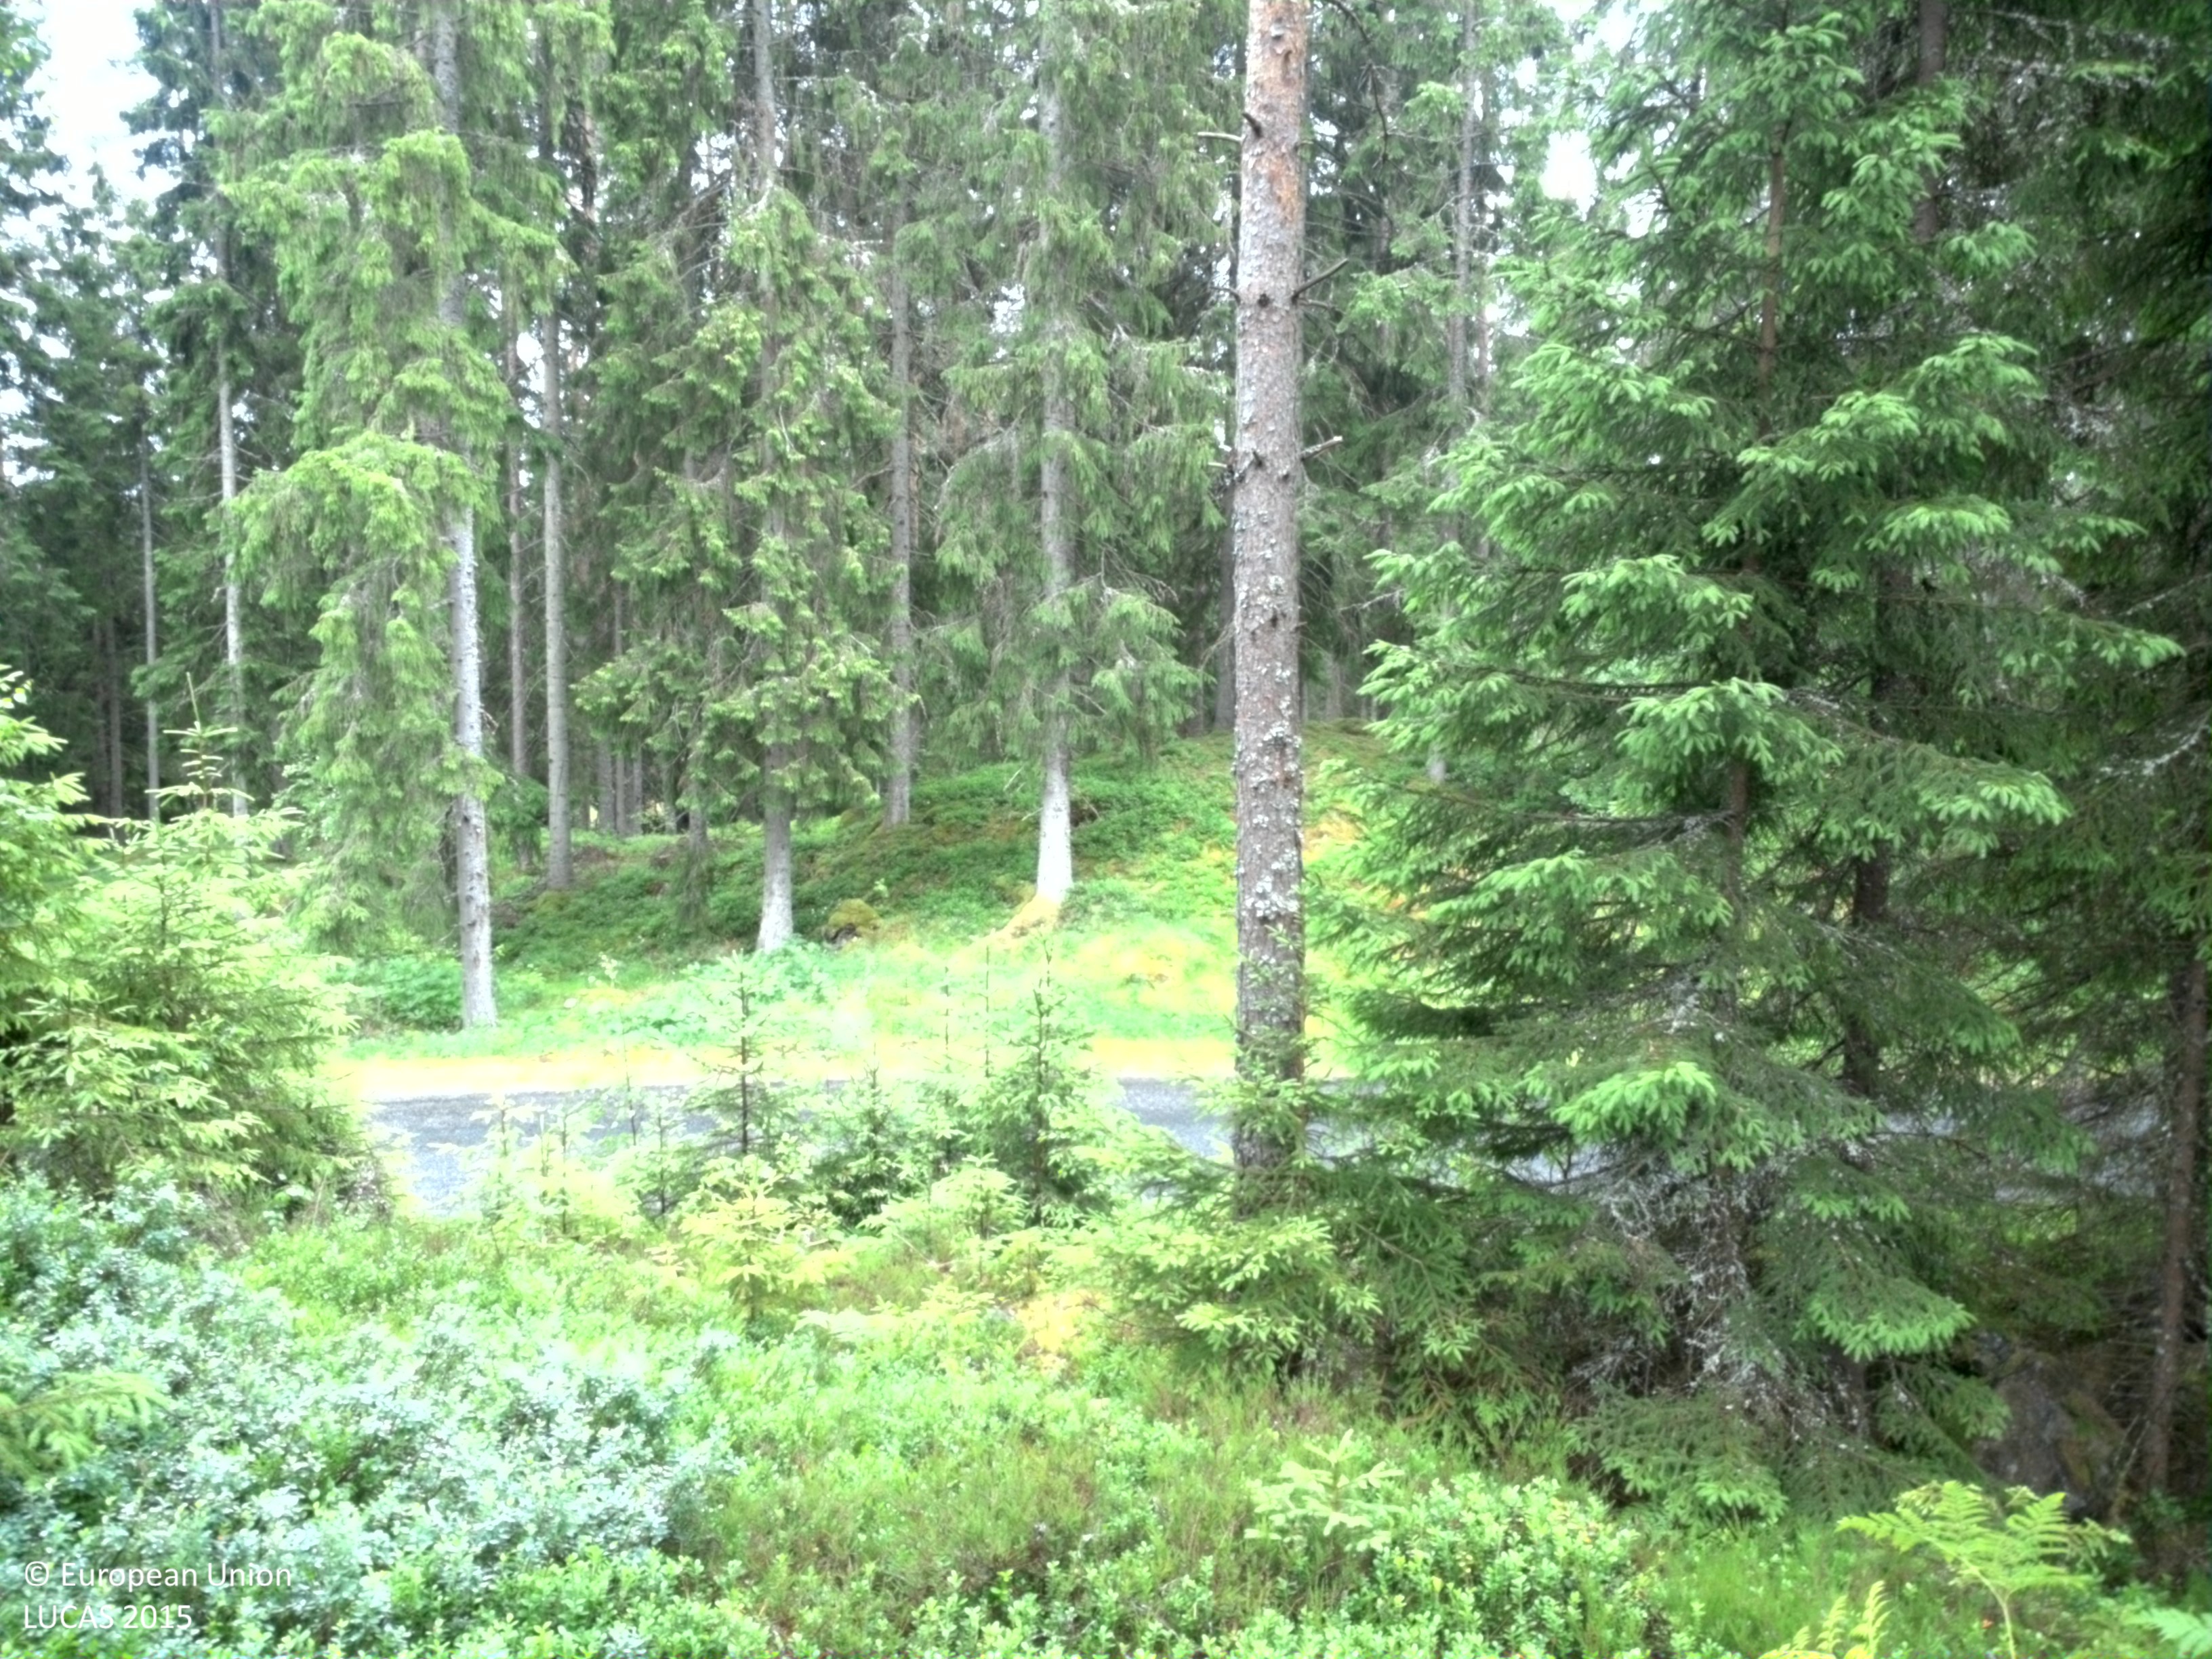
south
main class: Woodland
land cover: Spruce dominated coniferous woodland
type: boreal forest
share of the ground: 50 - 75 %
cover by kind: coniferous forest trees 75 %, shrubs 20 %, lichens and mosses 5 %
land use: Forestry
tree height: > 5 m
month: July
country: SE
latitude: 57.5882
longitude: 14.4283
